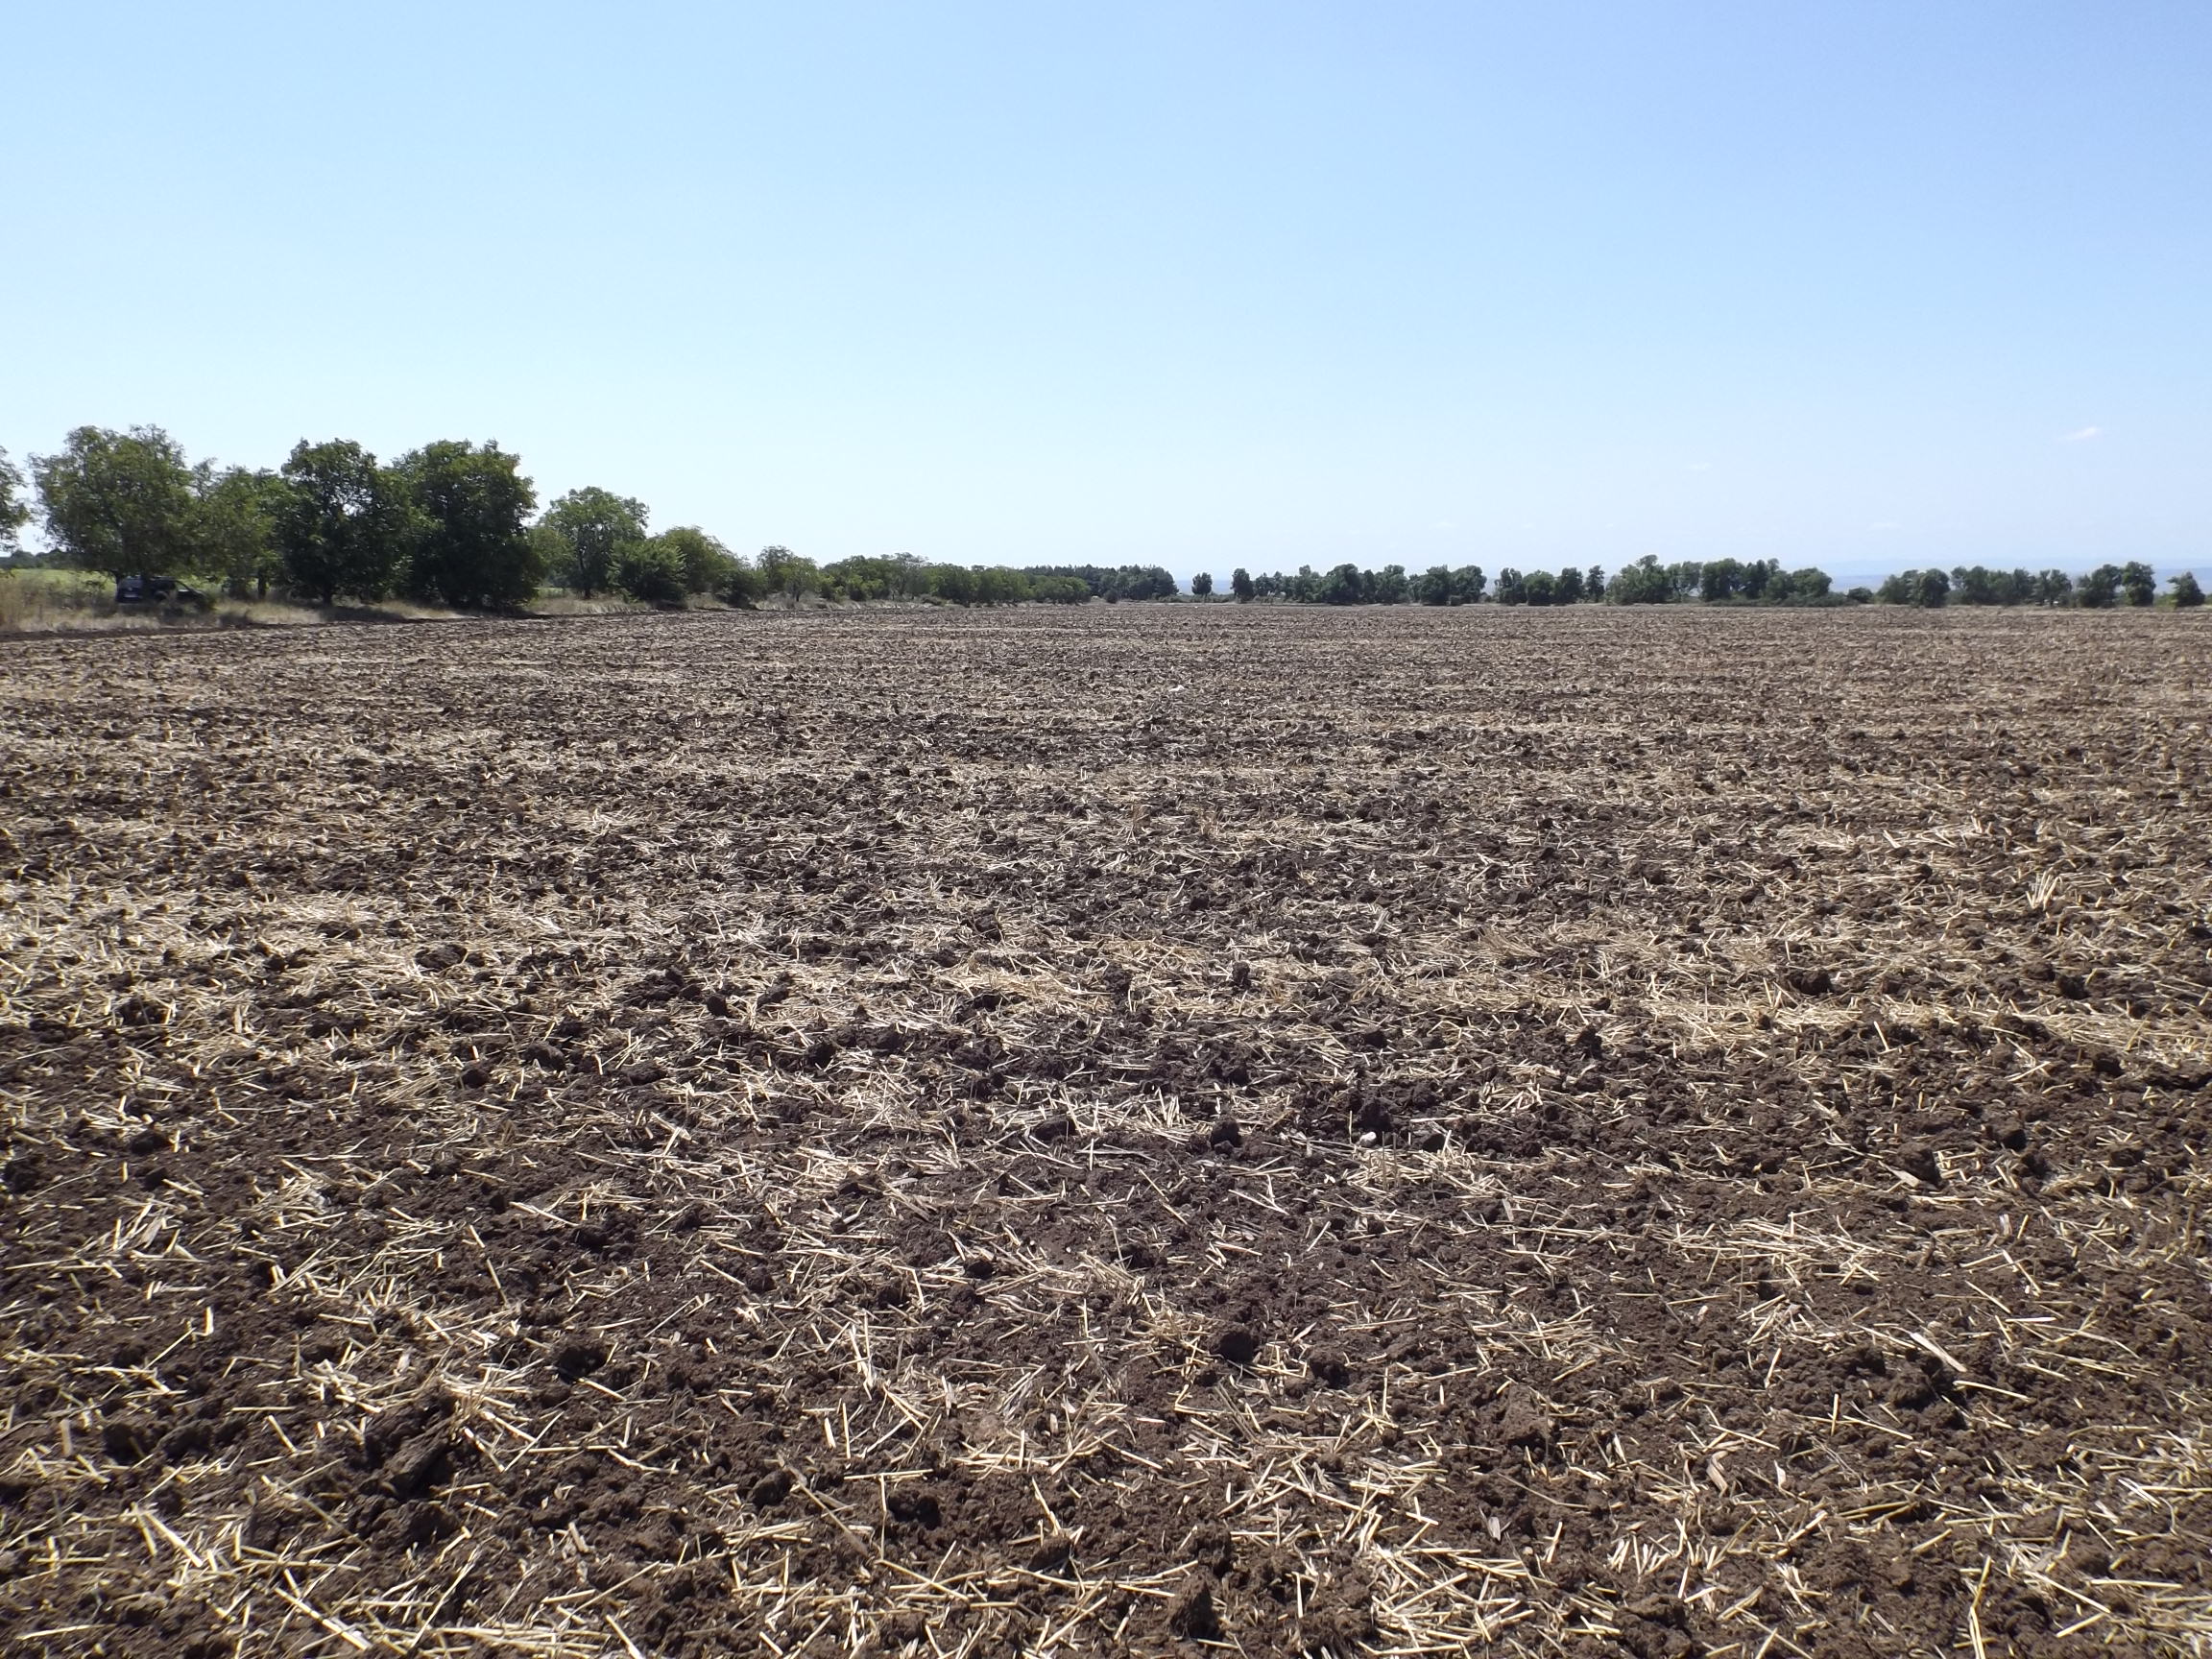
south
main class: Cropland
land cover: Common wheat
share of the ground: < 10 %
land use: Agriculture (excluding fallow land and kitchen gardens)
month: August
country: BG
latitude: 43.2596
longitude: 27.8904
